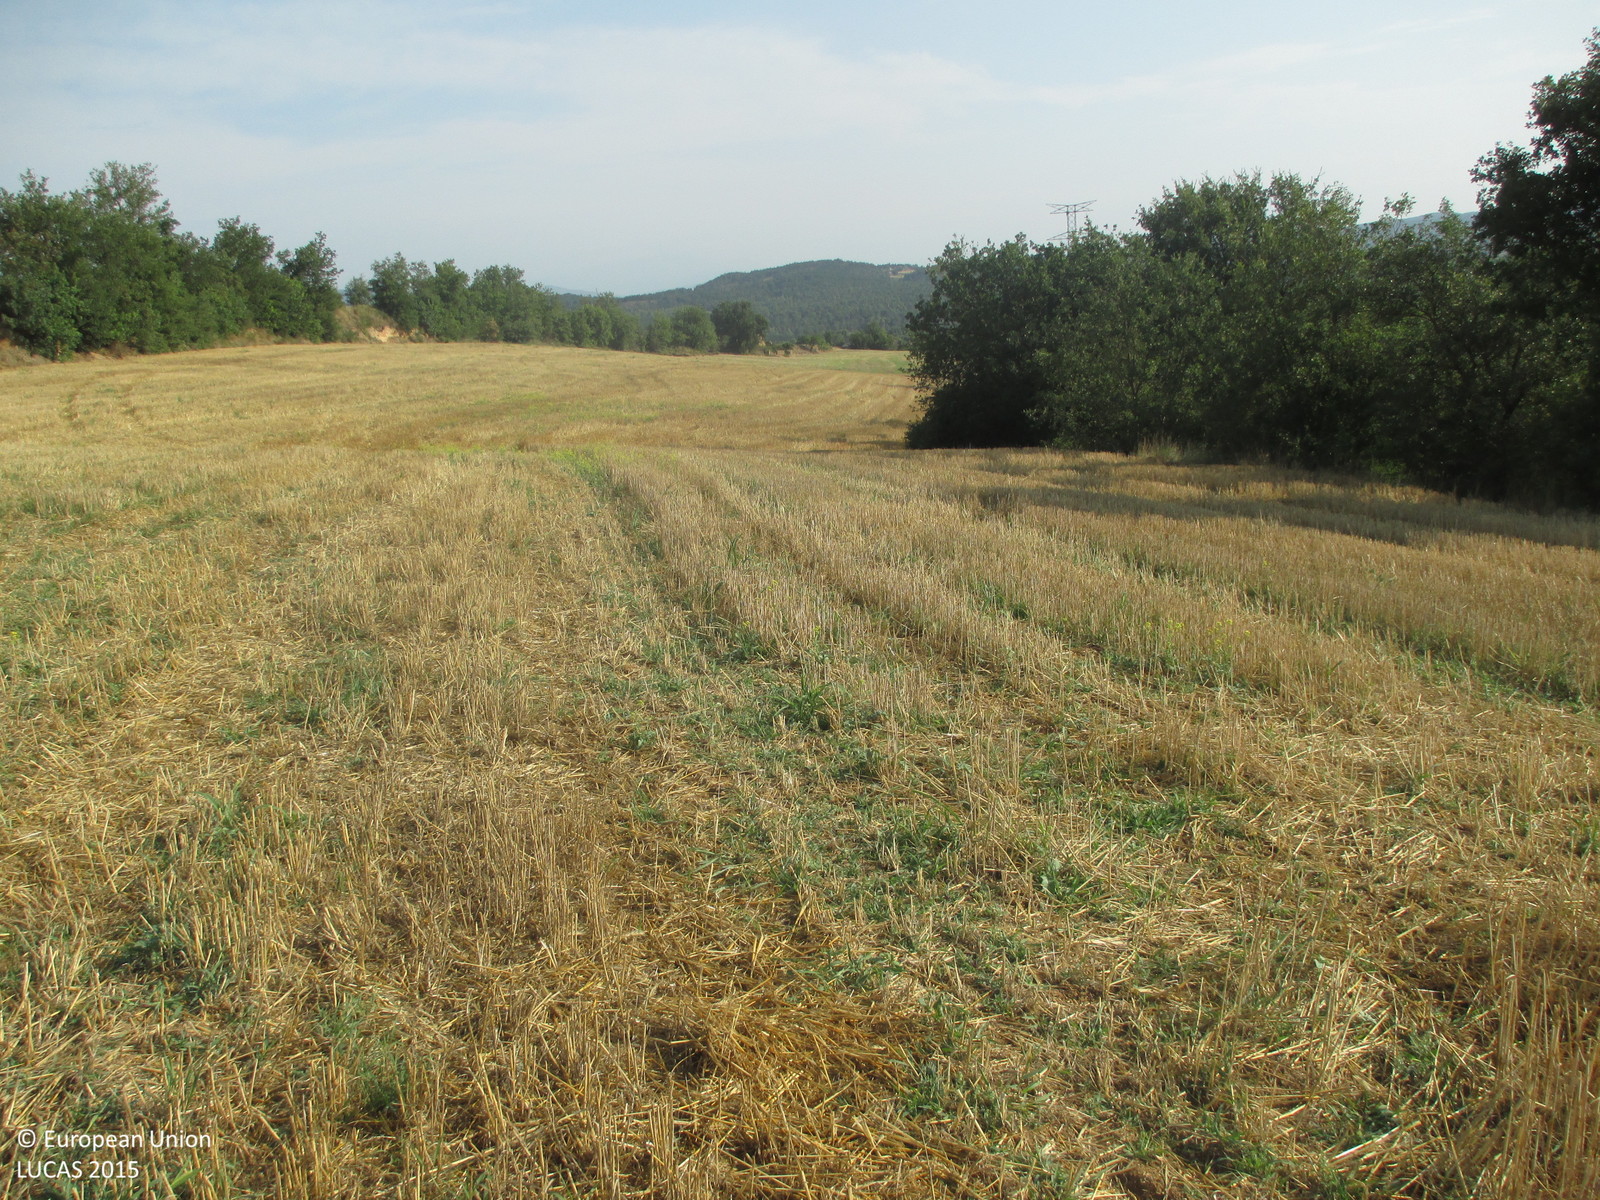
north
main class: Cropland
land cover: Common wheat
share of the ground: < 10 %
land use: Agriculture (excluding fallow land and kitchen gardens)
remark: Harvested field
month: July
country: ES
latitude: 42.1188
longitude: 0.3424
